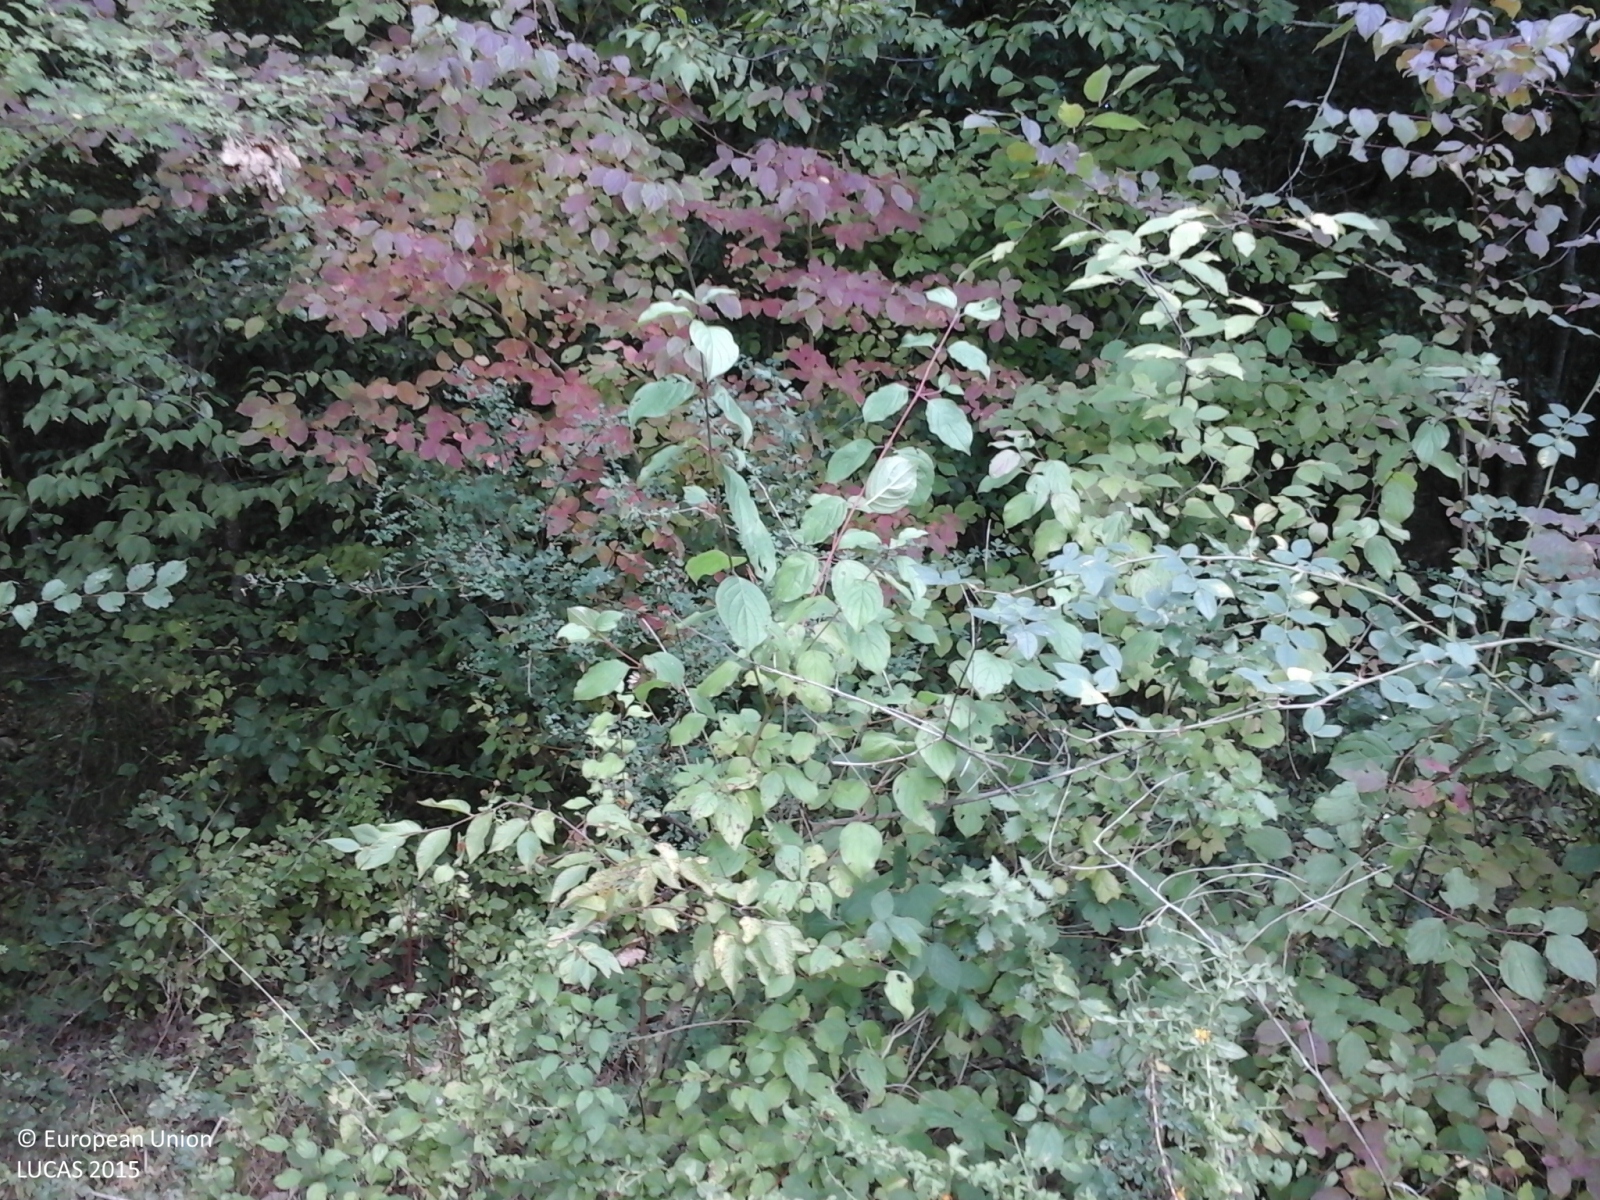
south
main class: Woodland
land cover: Broadleaved woodland
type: mesophytic deciduous forest
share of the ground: > 75 %
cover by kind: broadleaved forest trees 100 %
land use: Forestry
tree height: > 5 m
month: July
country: IT
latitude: 43.4982
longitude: 10.9496
